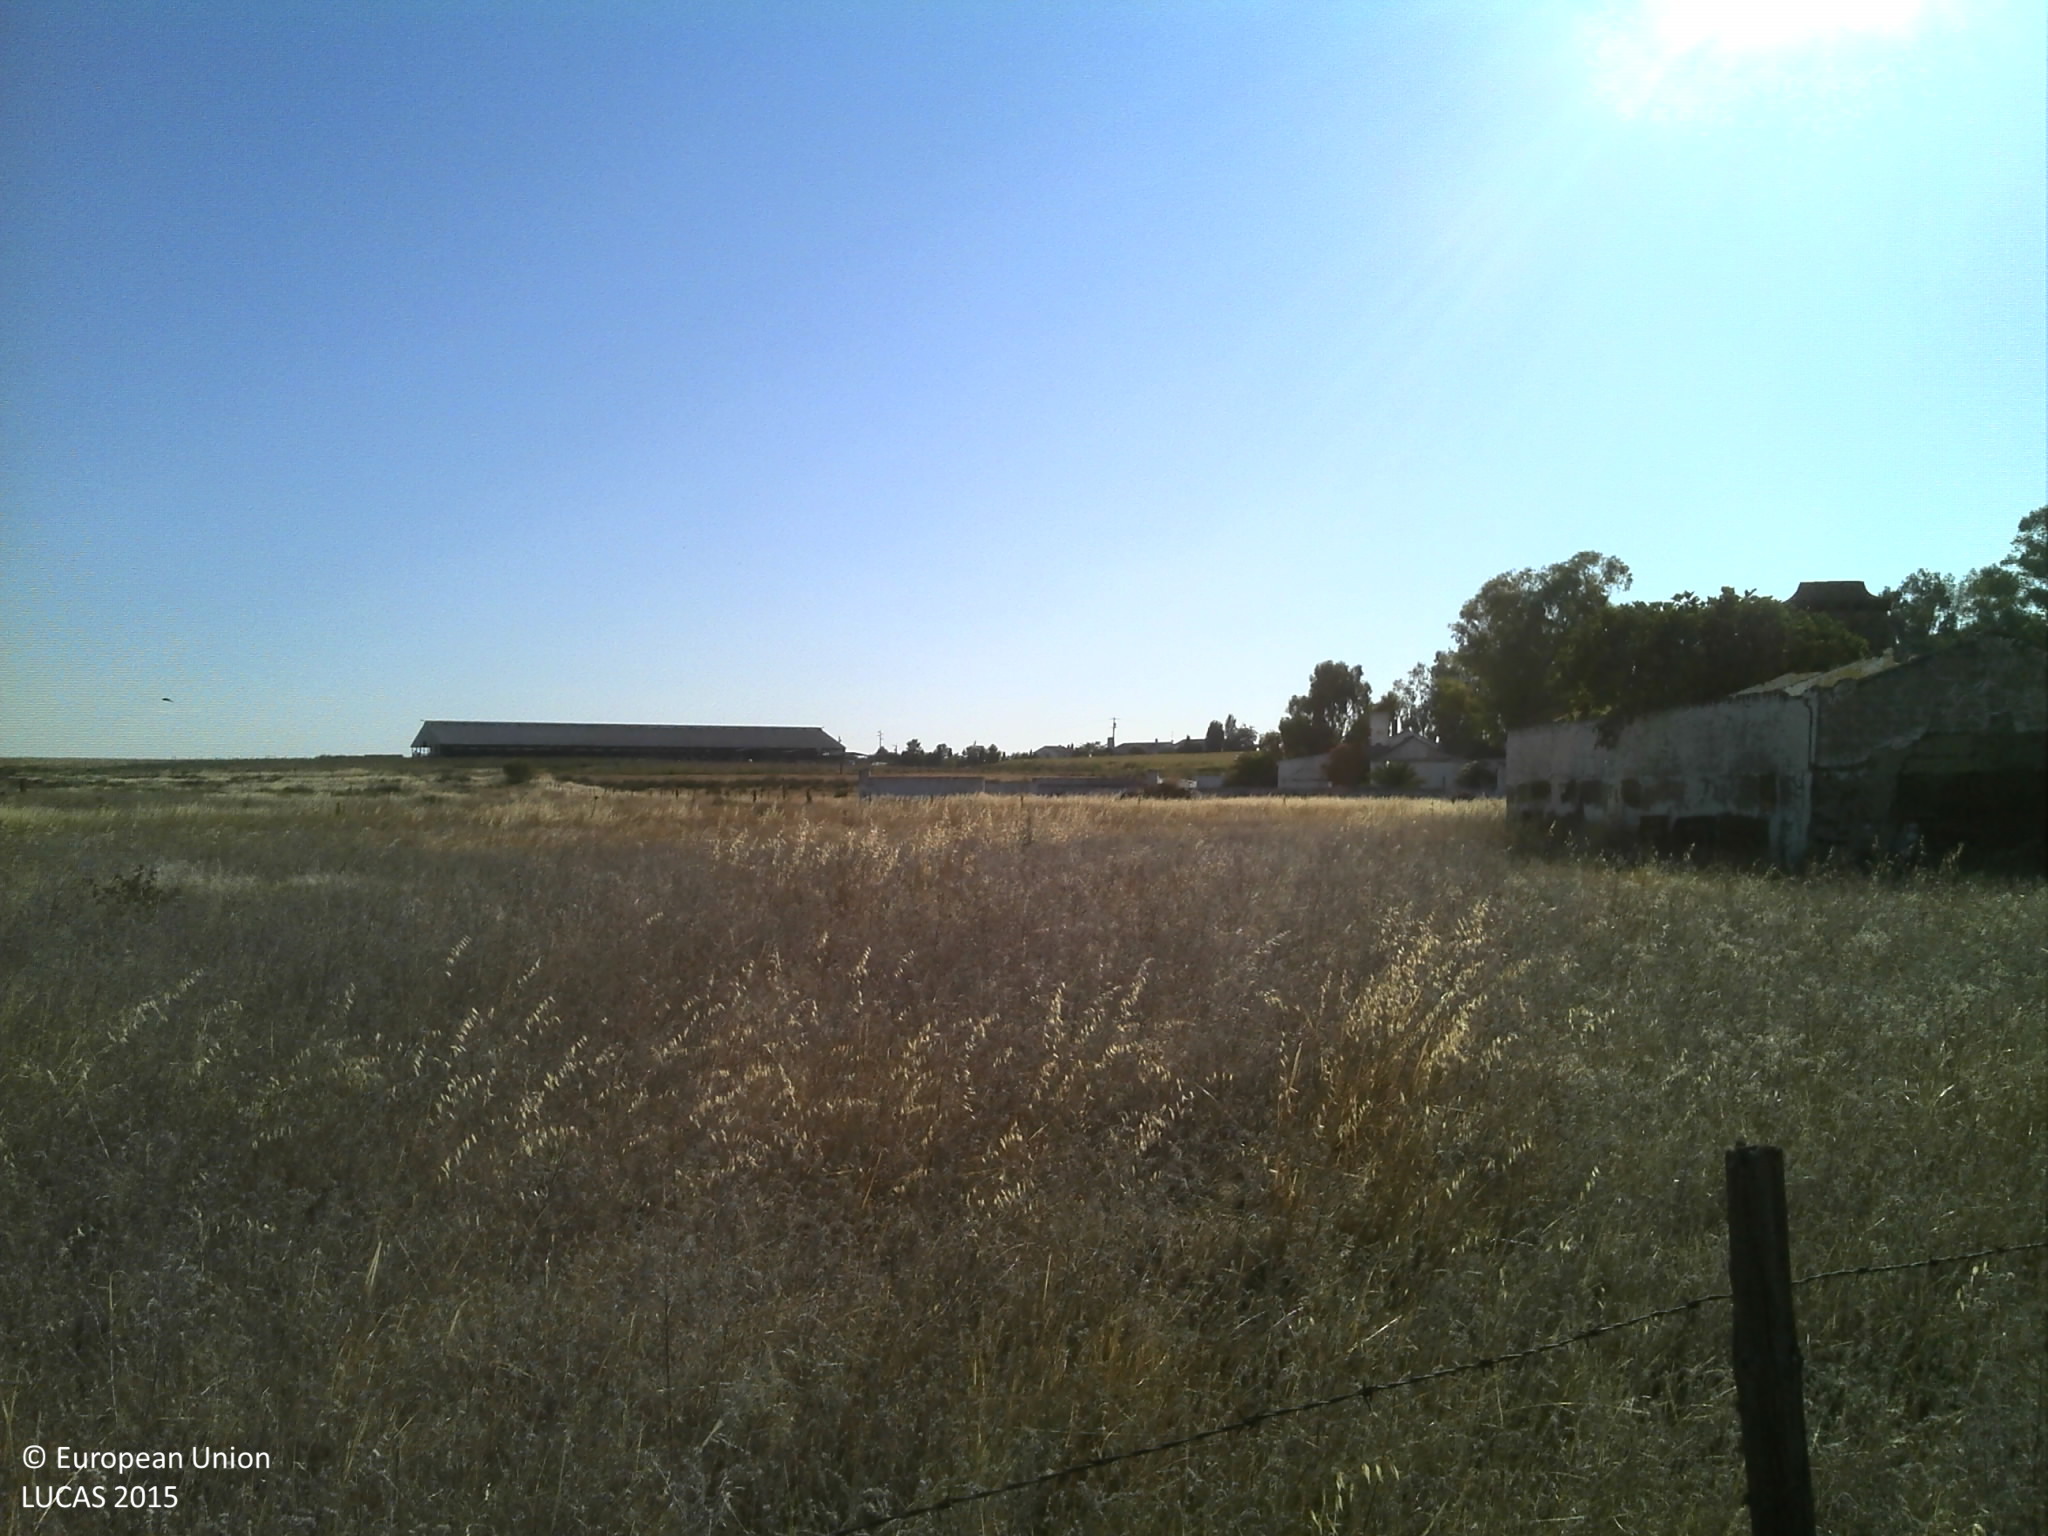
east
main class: Grassland
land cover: Grassland without tree/shrub cover
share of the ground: 50 - 75 %
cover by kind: herbaceous plants 75 %, unconsolidated bare surface 25 %
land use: Agriculture (excluding fallow land and kitchen gardens)
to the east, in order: Grass margins; Fences; Grassland without tree/shrub cover; Artificial constructions in urban areas; Grassland without tree/shrub cover; Fences; Grass margins; Tracks; Grass margins; Fences; Grassland without tree/shrub cover; Artificial constructions in urban areas; Grassland without tree/shrub cover; Electric lines; Grassland without tree/shrub cover; Broadleaved woodland
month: July
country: PT
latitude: 38.9261
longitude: -7.0633
